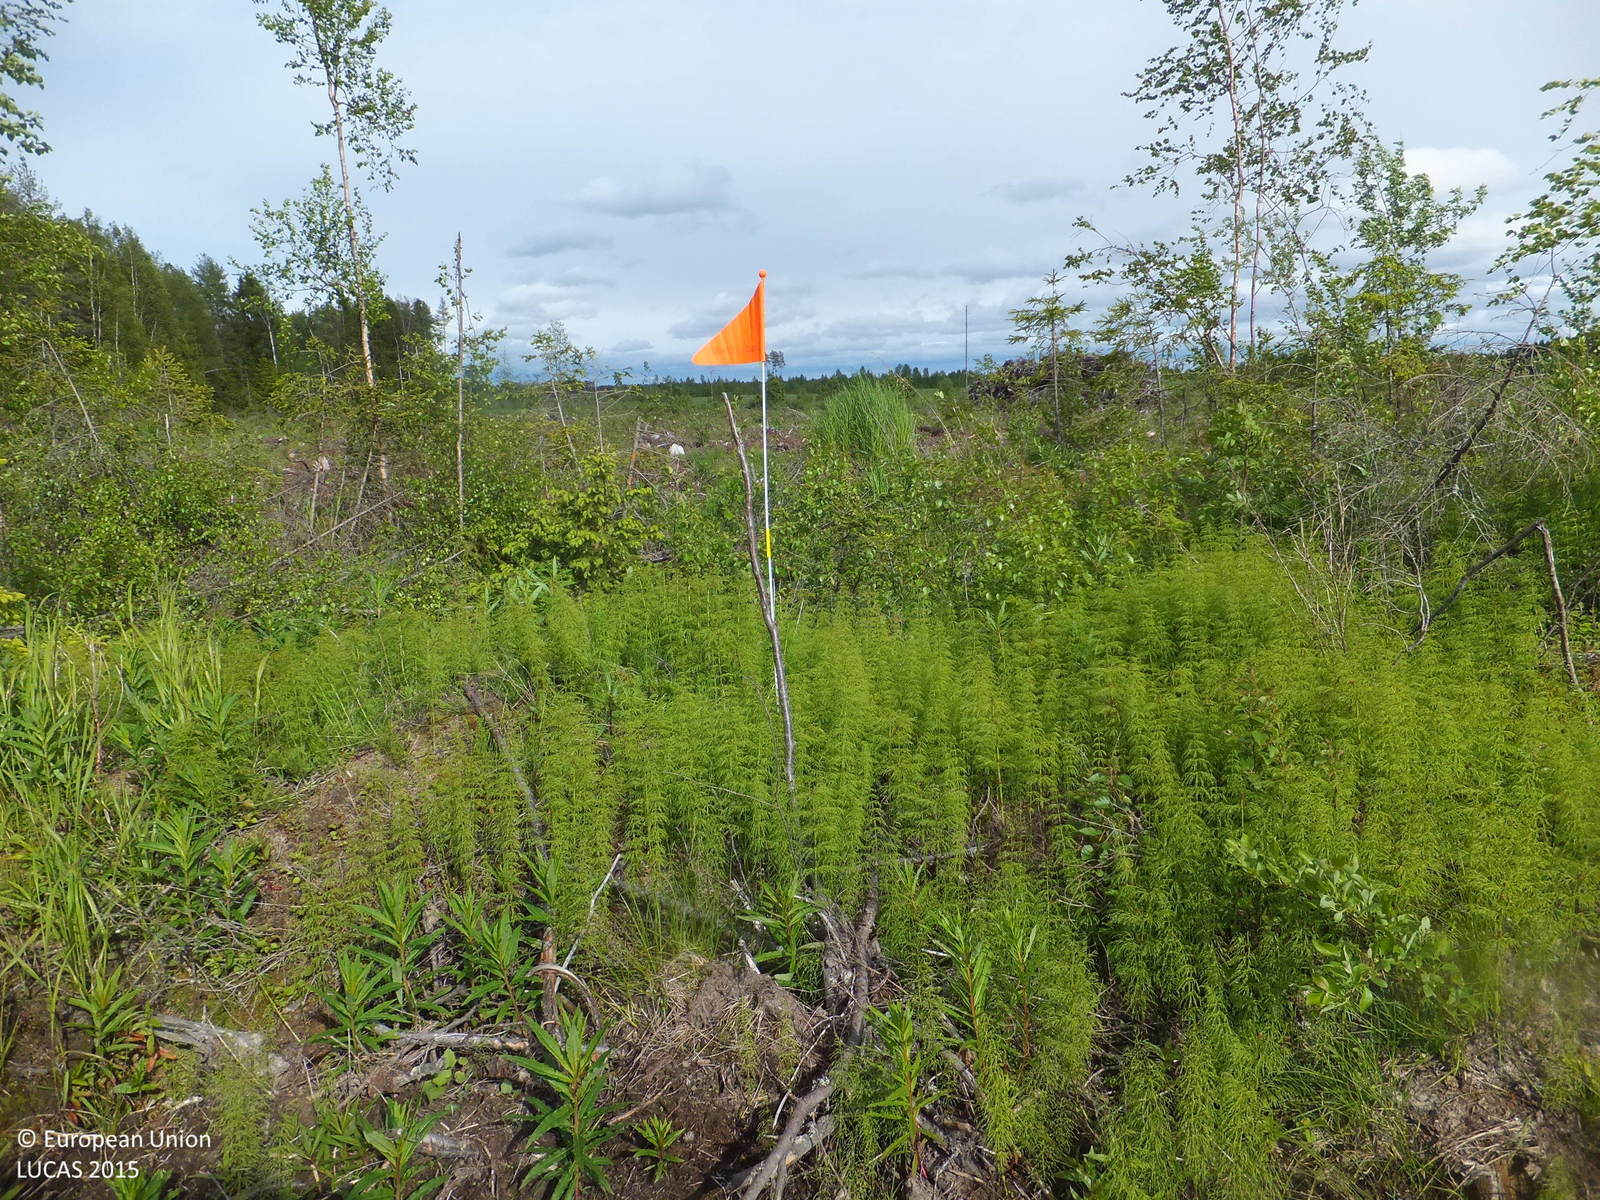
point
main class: Grassland
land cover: Spontaneously vegetated surfaces
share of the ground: 50 - 75 %
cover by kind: herbaceous plants 60 %, unconsolidated bare surface 35 %, shrubs 5 %
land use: Forestry
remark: Clear cut
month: June
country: FI
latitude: 63.2733
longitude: 22.7885
